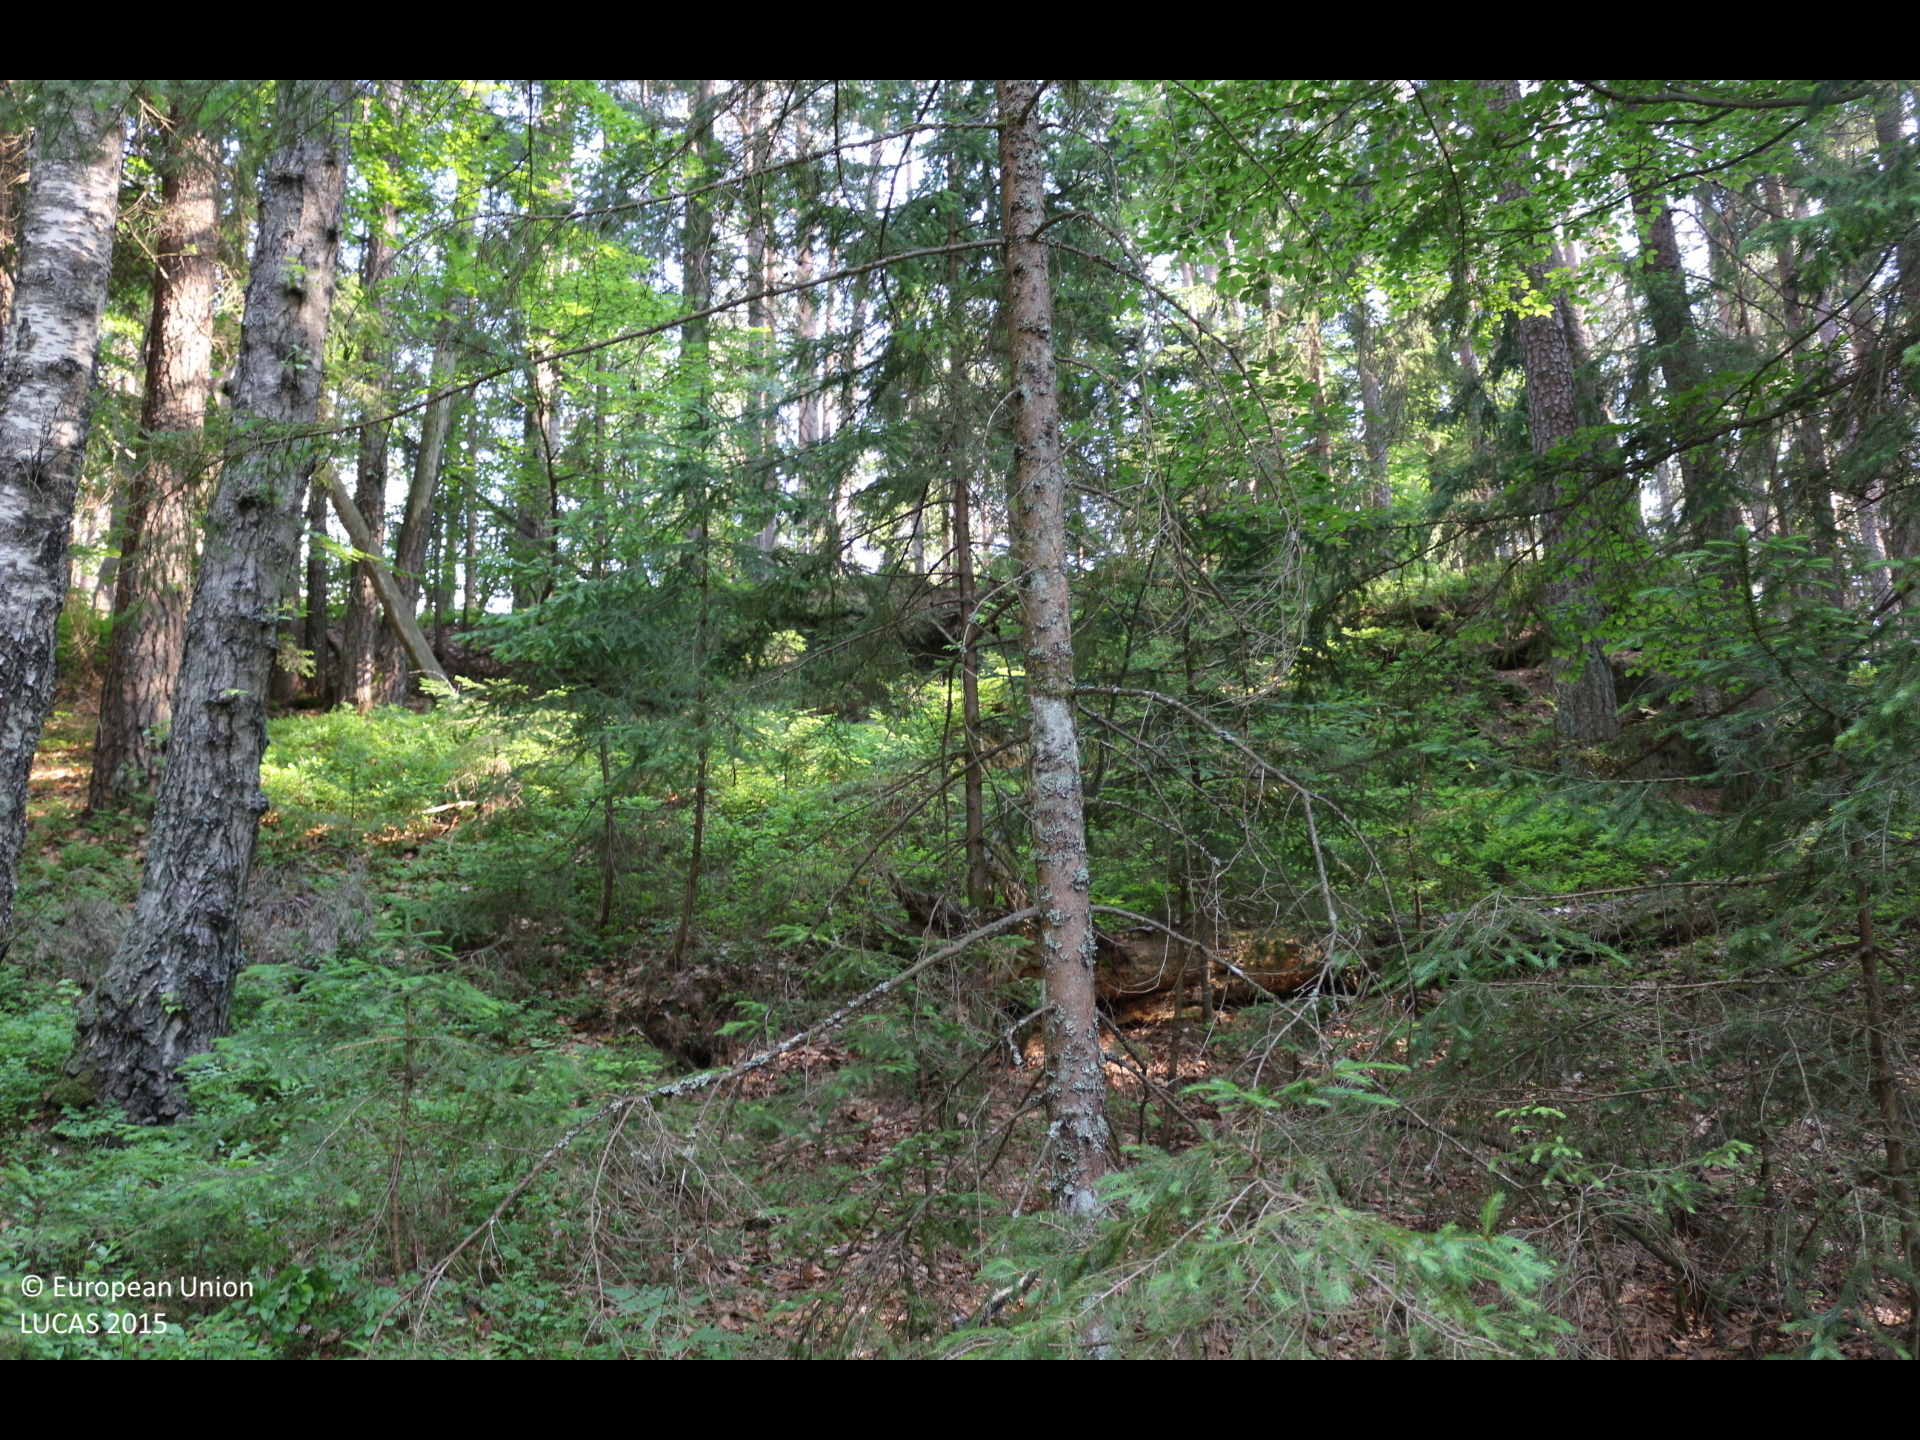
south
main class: Woodland
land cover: Other mixed woodland
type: alpine coniferous forest
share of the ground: > 75 %
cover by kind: coniferous forest trees 70 %, broadleaved forest trees 25 %, herbaceous plants 5 %
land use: Forestry
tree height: > 5 m
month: June
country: AT
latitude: 46.6368
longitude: 14.0076
